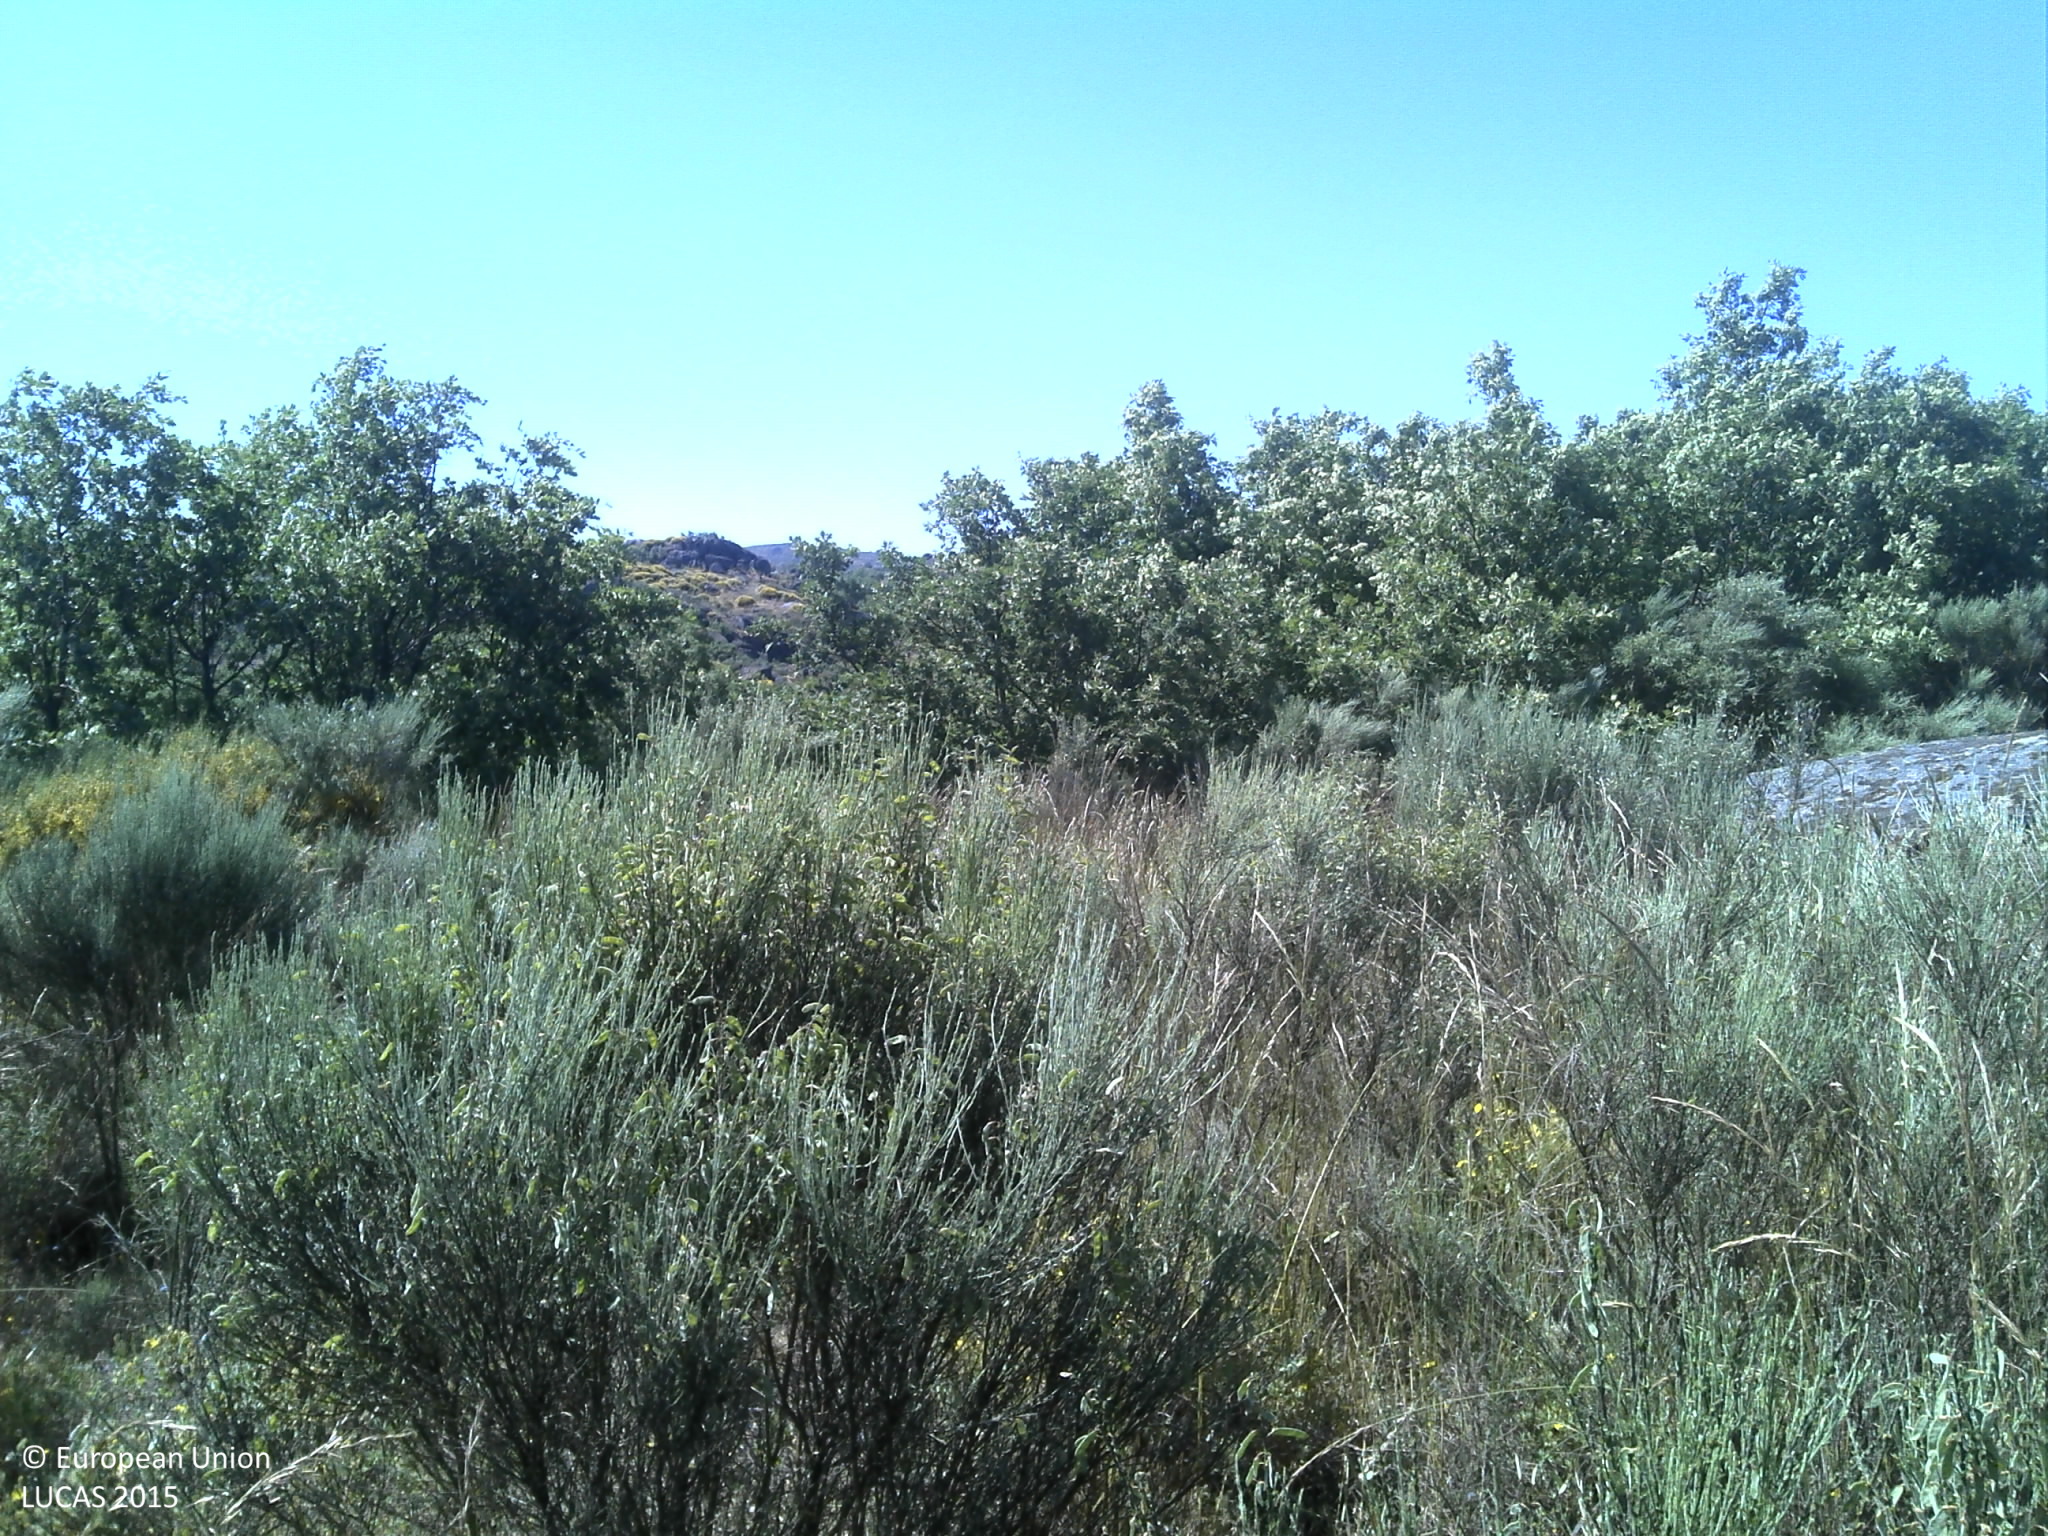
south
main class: Shrubland
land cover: Shrubland with sparse tree cover
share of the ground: 25 - 50 %
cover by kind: shrubs 70 %, unconsolidated bare surface 10 %, broadleaved forest trees 5 %, herbaceous plants 5 %
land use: Semi-natural and natural areas not in use
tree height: < 5 m
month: May
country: PT
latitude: 40.6138
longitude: -7.1120
